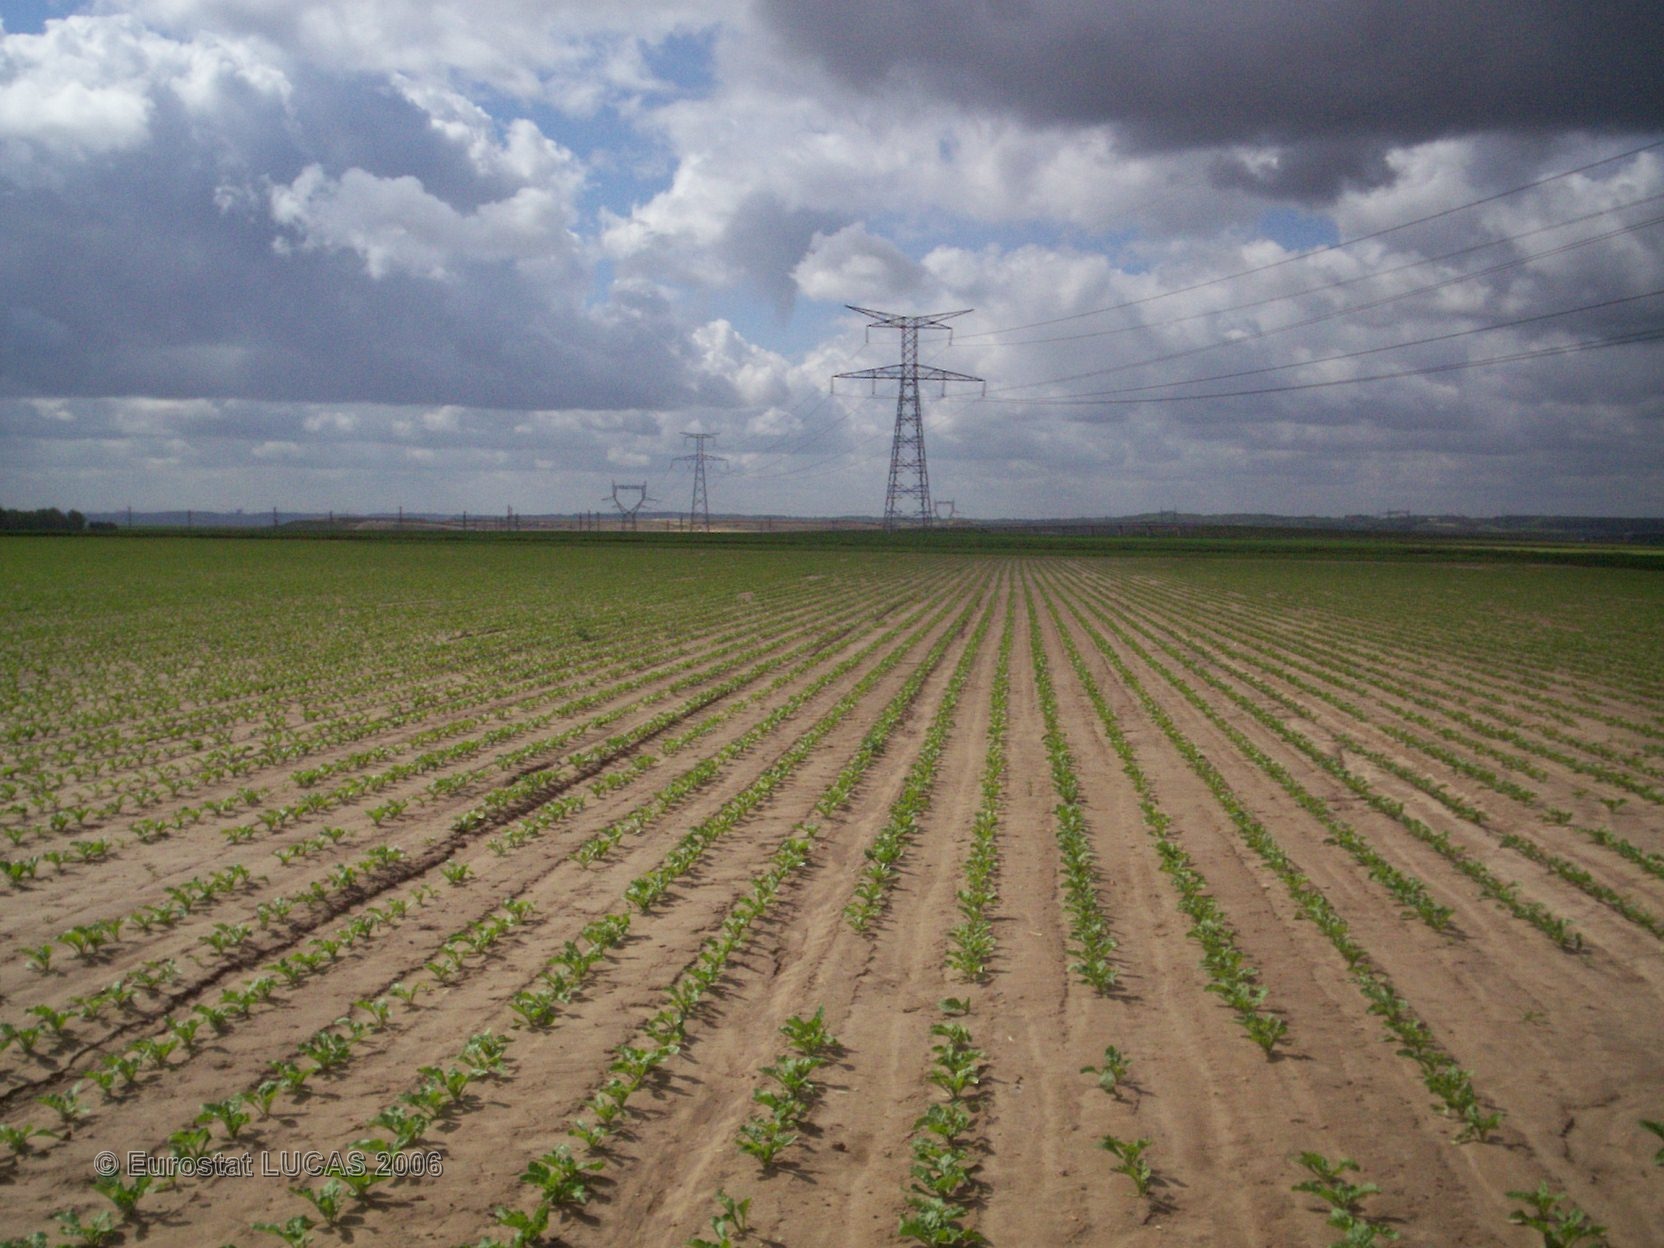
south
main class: Cropland
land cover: Sugar beet
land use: Agriculture (excluding fallow land and kitchen gardens)
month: May
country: FR
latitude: 48.9772
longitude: 2.7350
